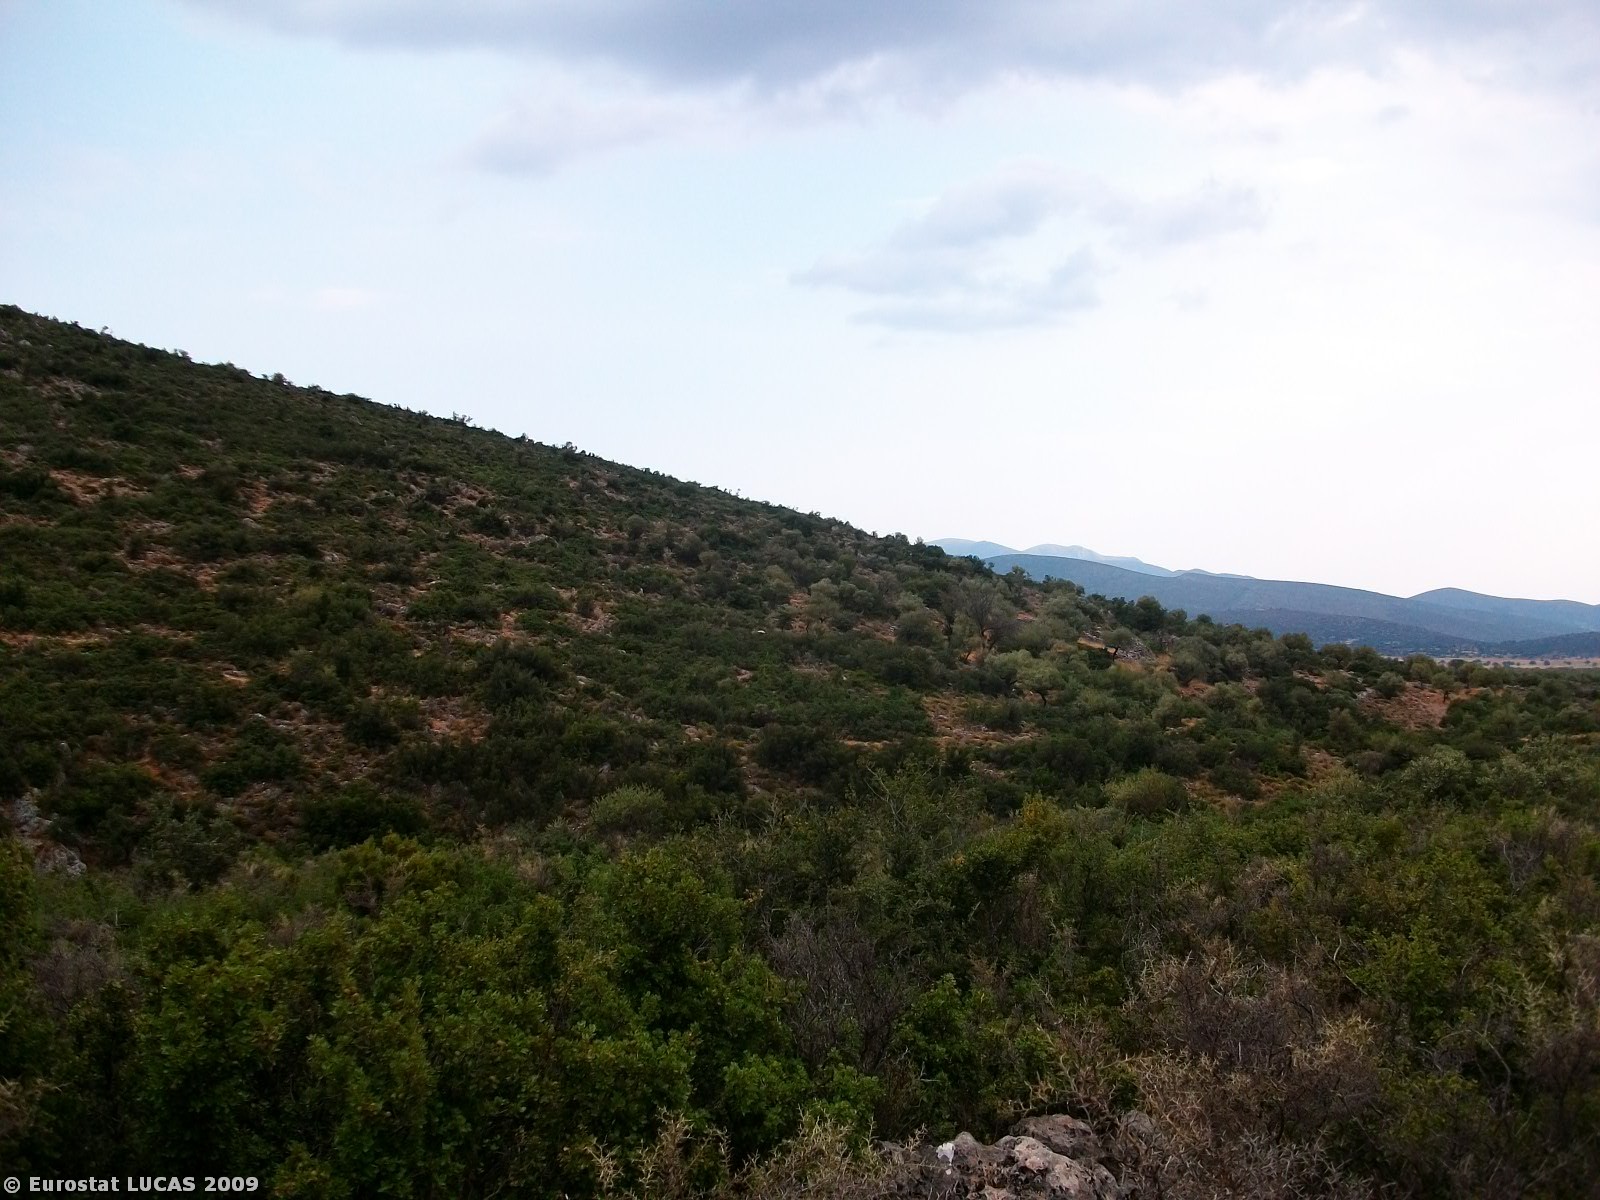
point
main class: Shrubland
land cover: Shrubland without tree cover
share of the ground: > 75 %
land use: Unused
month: August
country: GR
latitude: 36.9291
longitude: 22.8334
